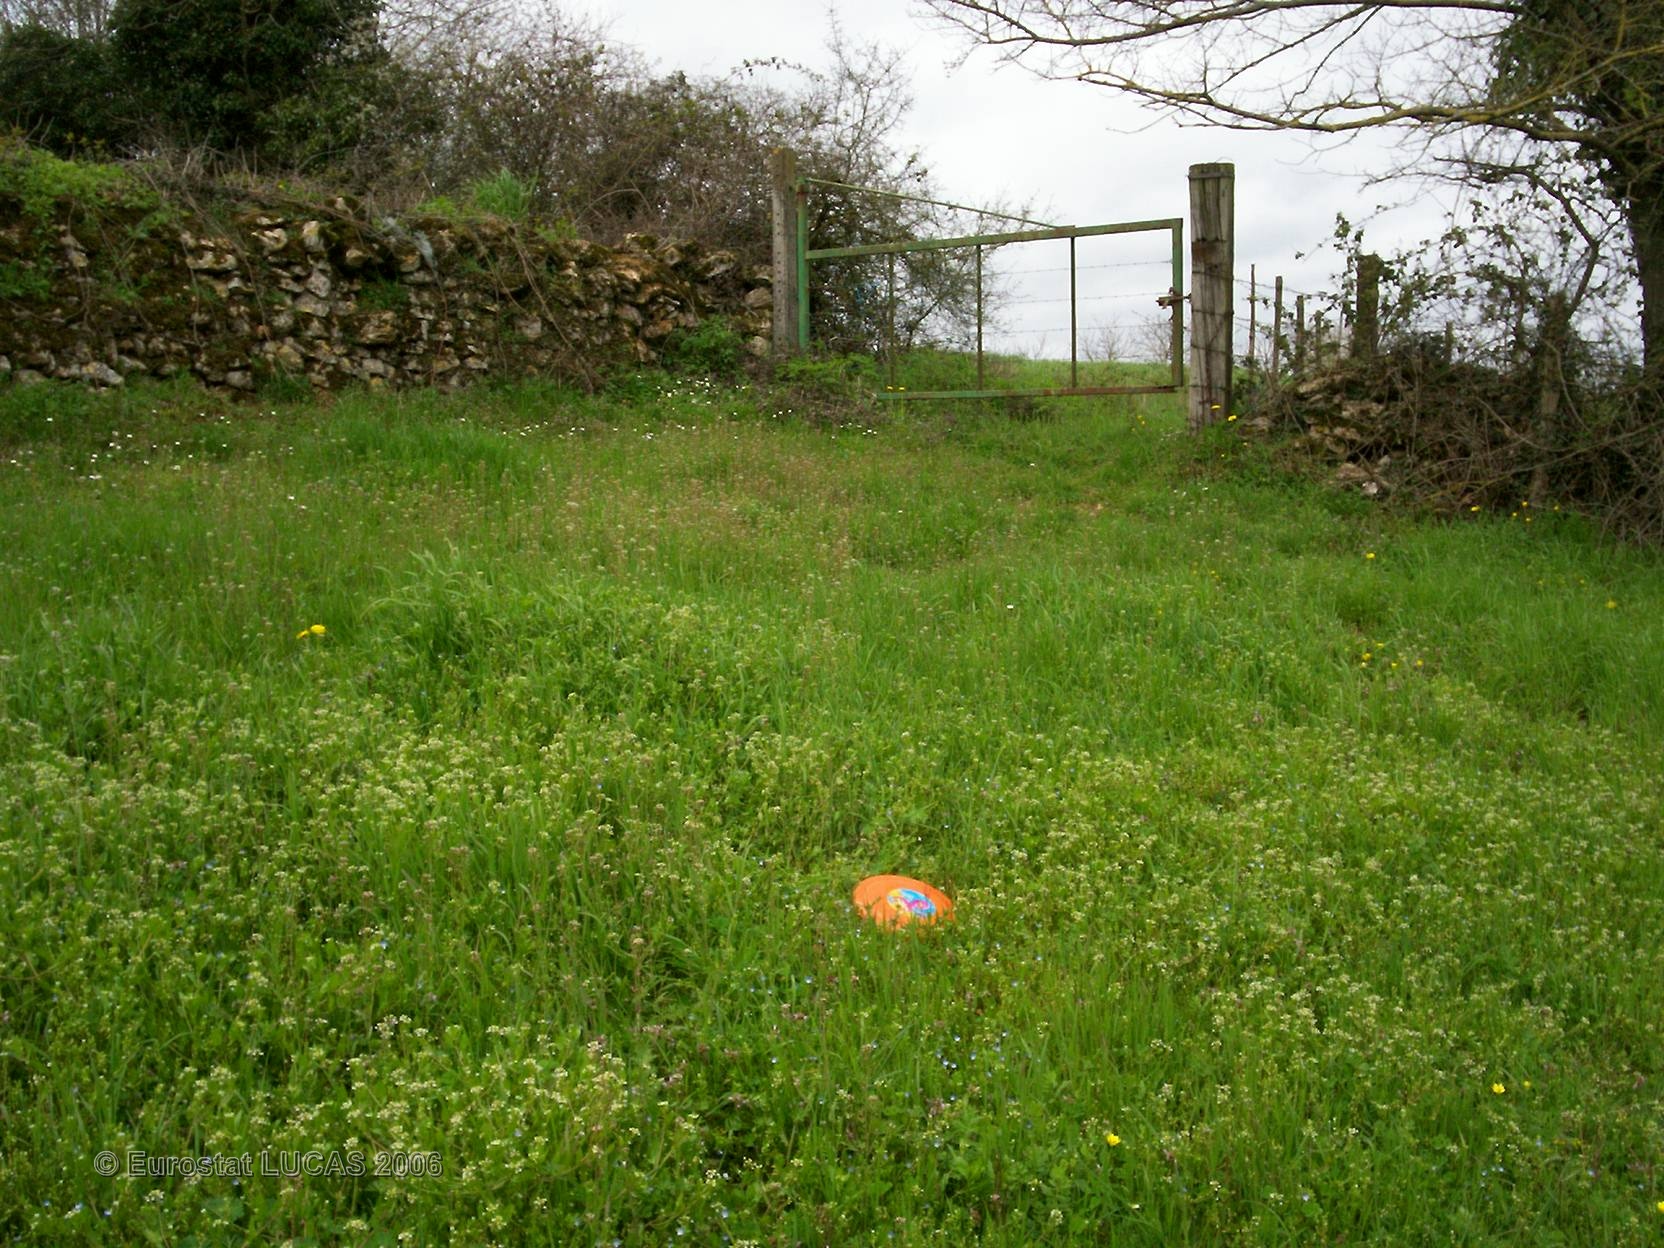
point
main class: Grassland
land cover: Grassland without tree/shrub cover
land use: Agriculture (excluding fallow land and kitchen gardens)
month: April
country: FR
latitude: 46.3095
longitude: -0.2685
